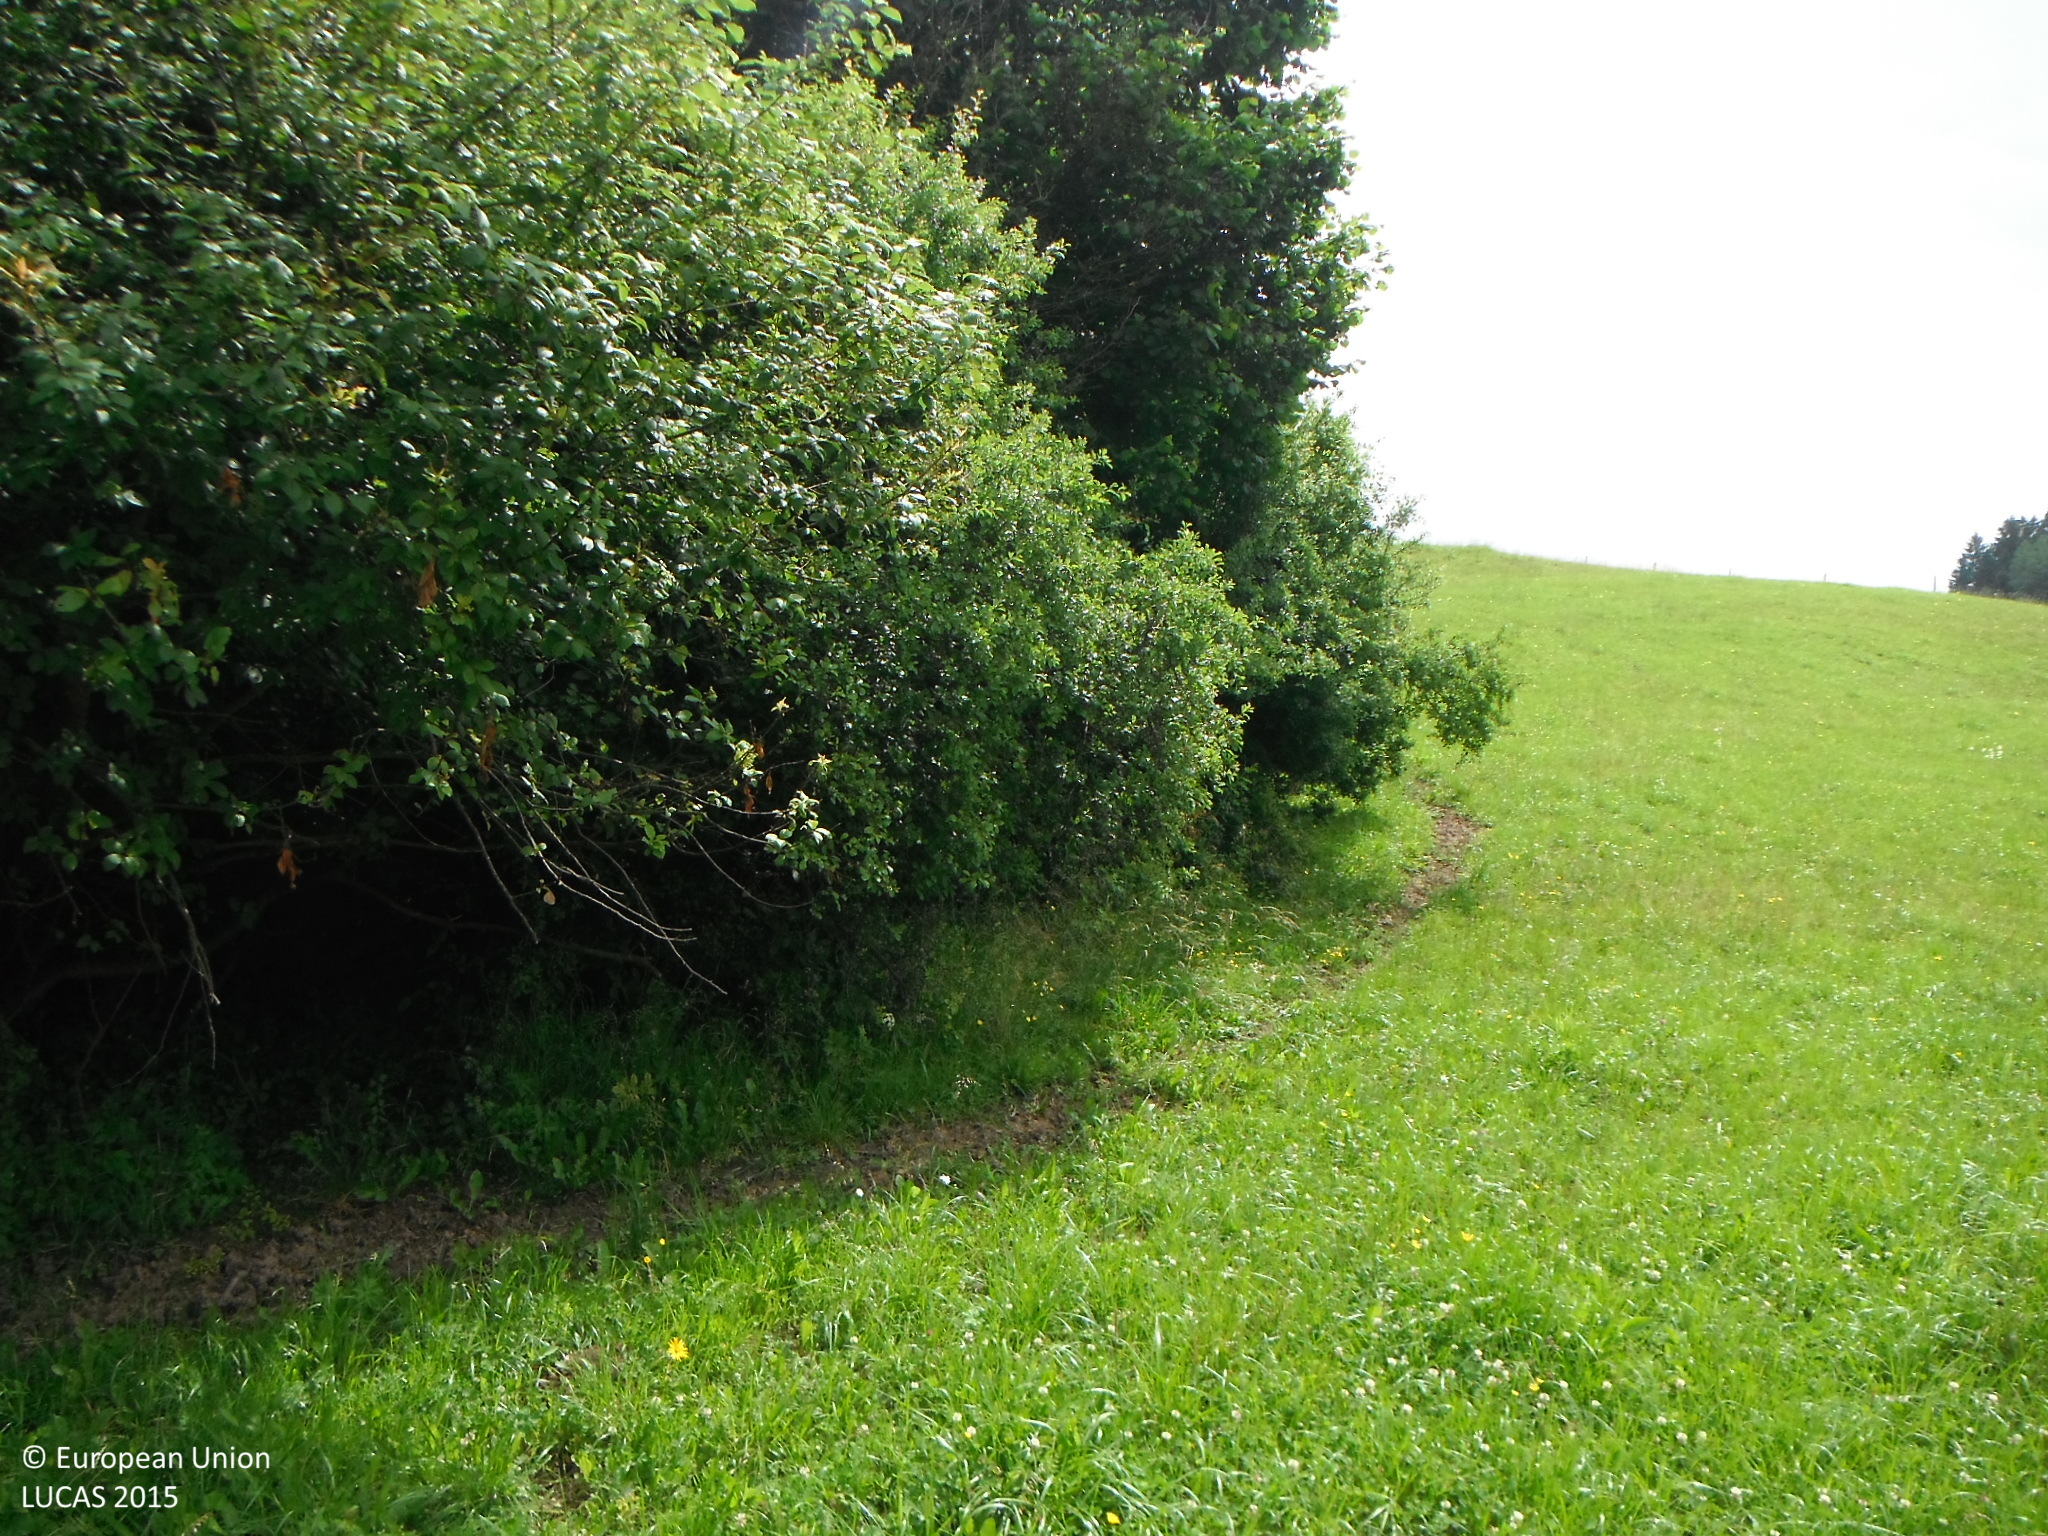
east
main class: Grassland
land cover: Grassland without tree/shrub cover
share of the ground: > 75 %
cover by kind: herbaceous plants 100 %
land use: Agriculture (excluding fallow land and kitchen gardens)
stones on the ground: < 10 %
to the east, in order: Grassland without tree/shrub cover; Broadleaved woodland; Grassland without tree/shrub cover; Broadleaved woodland; Grassland without tree/shrub cover
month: June
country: SK
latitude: 49.2269
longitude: 19.2655
